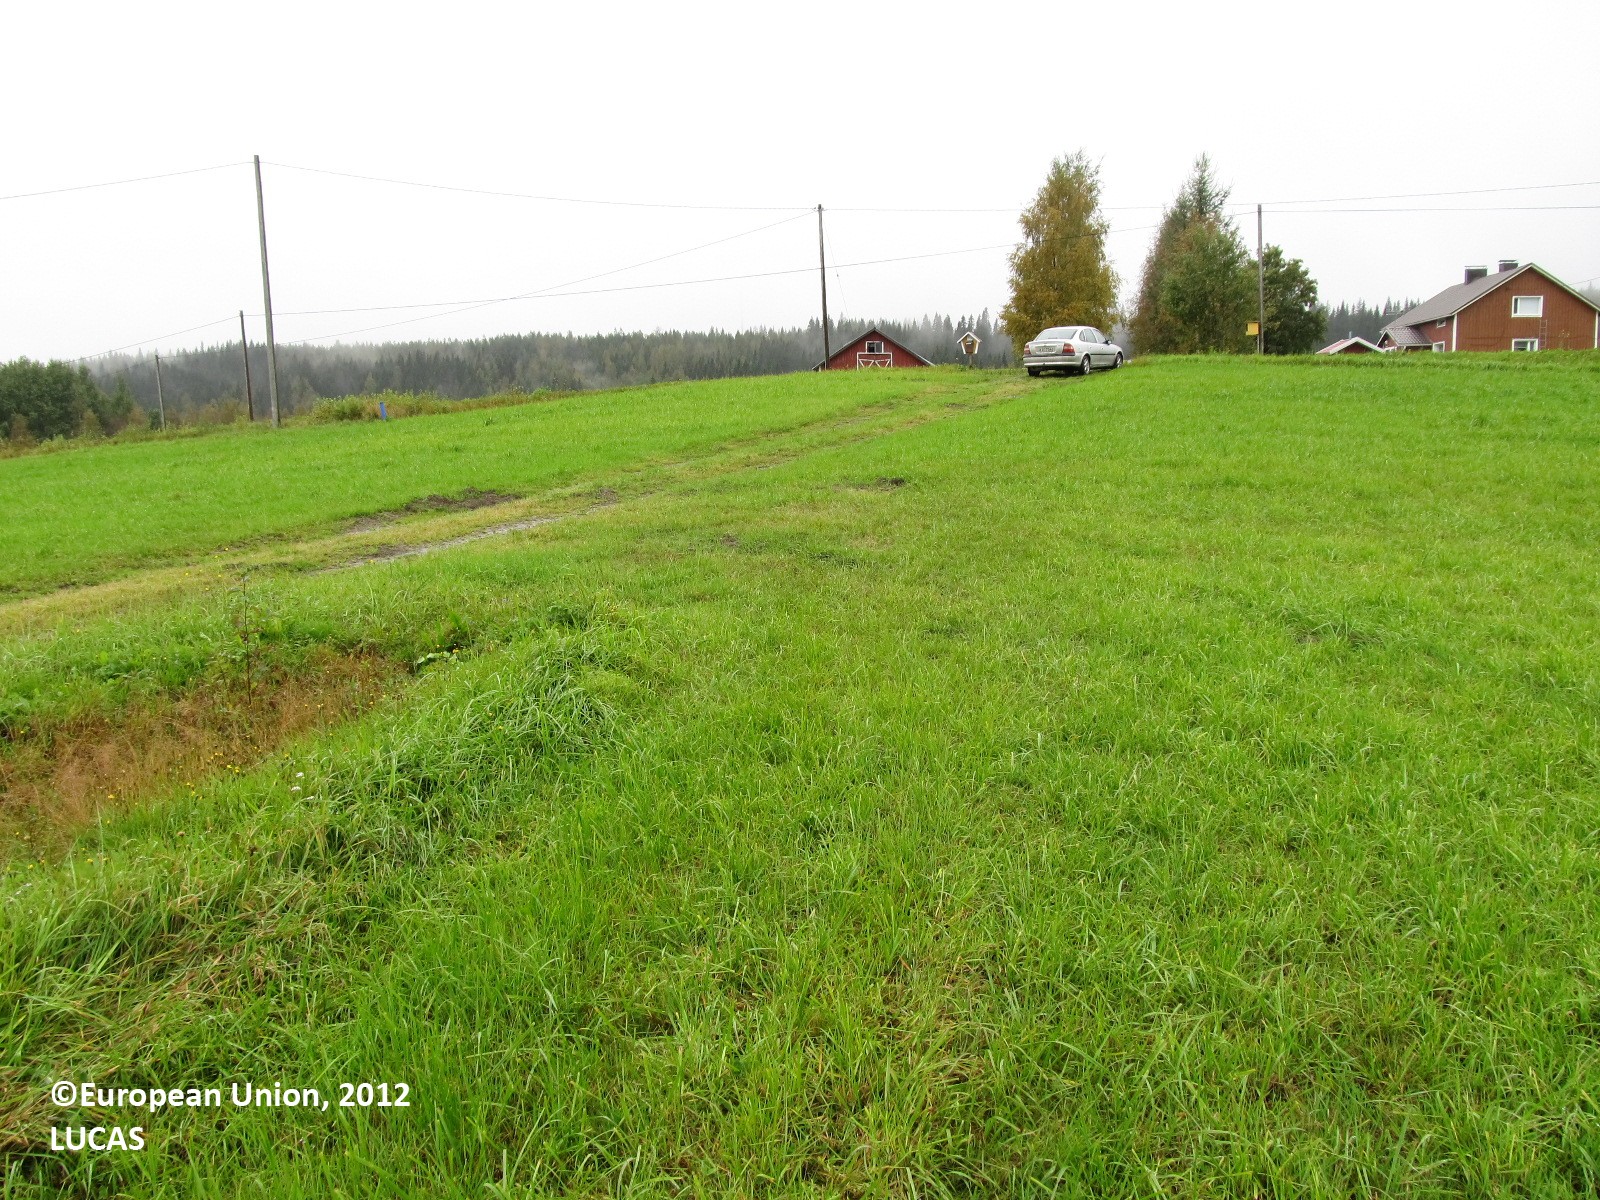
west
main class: Cropland
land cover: Temporary grasslands
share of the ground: > 75 %
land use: Agriculture (excluding fallow land and kitchen gardens)
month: September
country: FI
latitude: 63.1477
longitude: 28.0165
